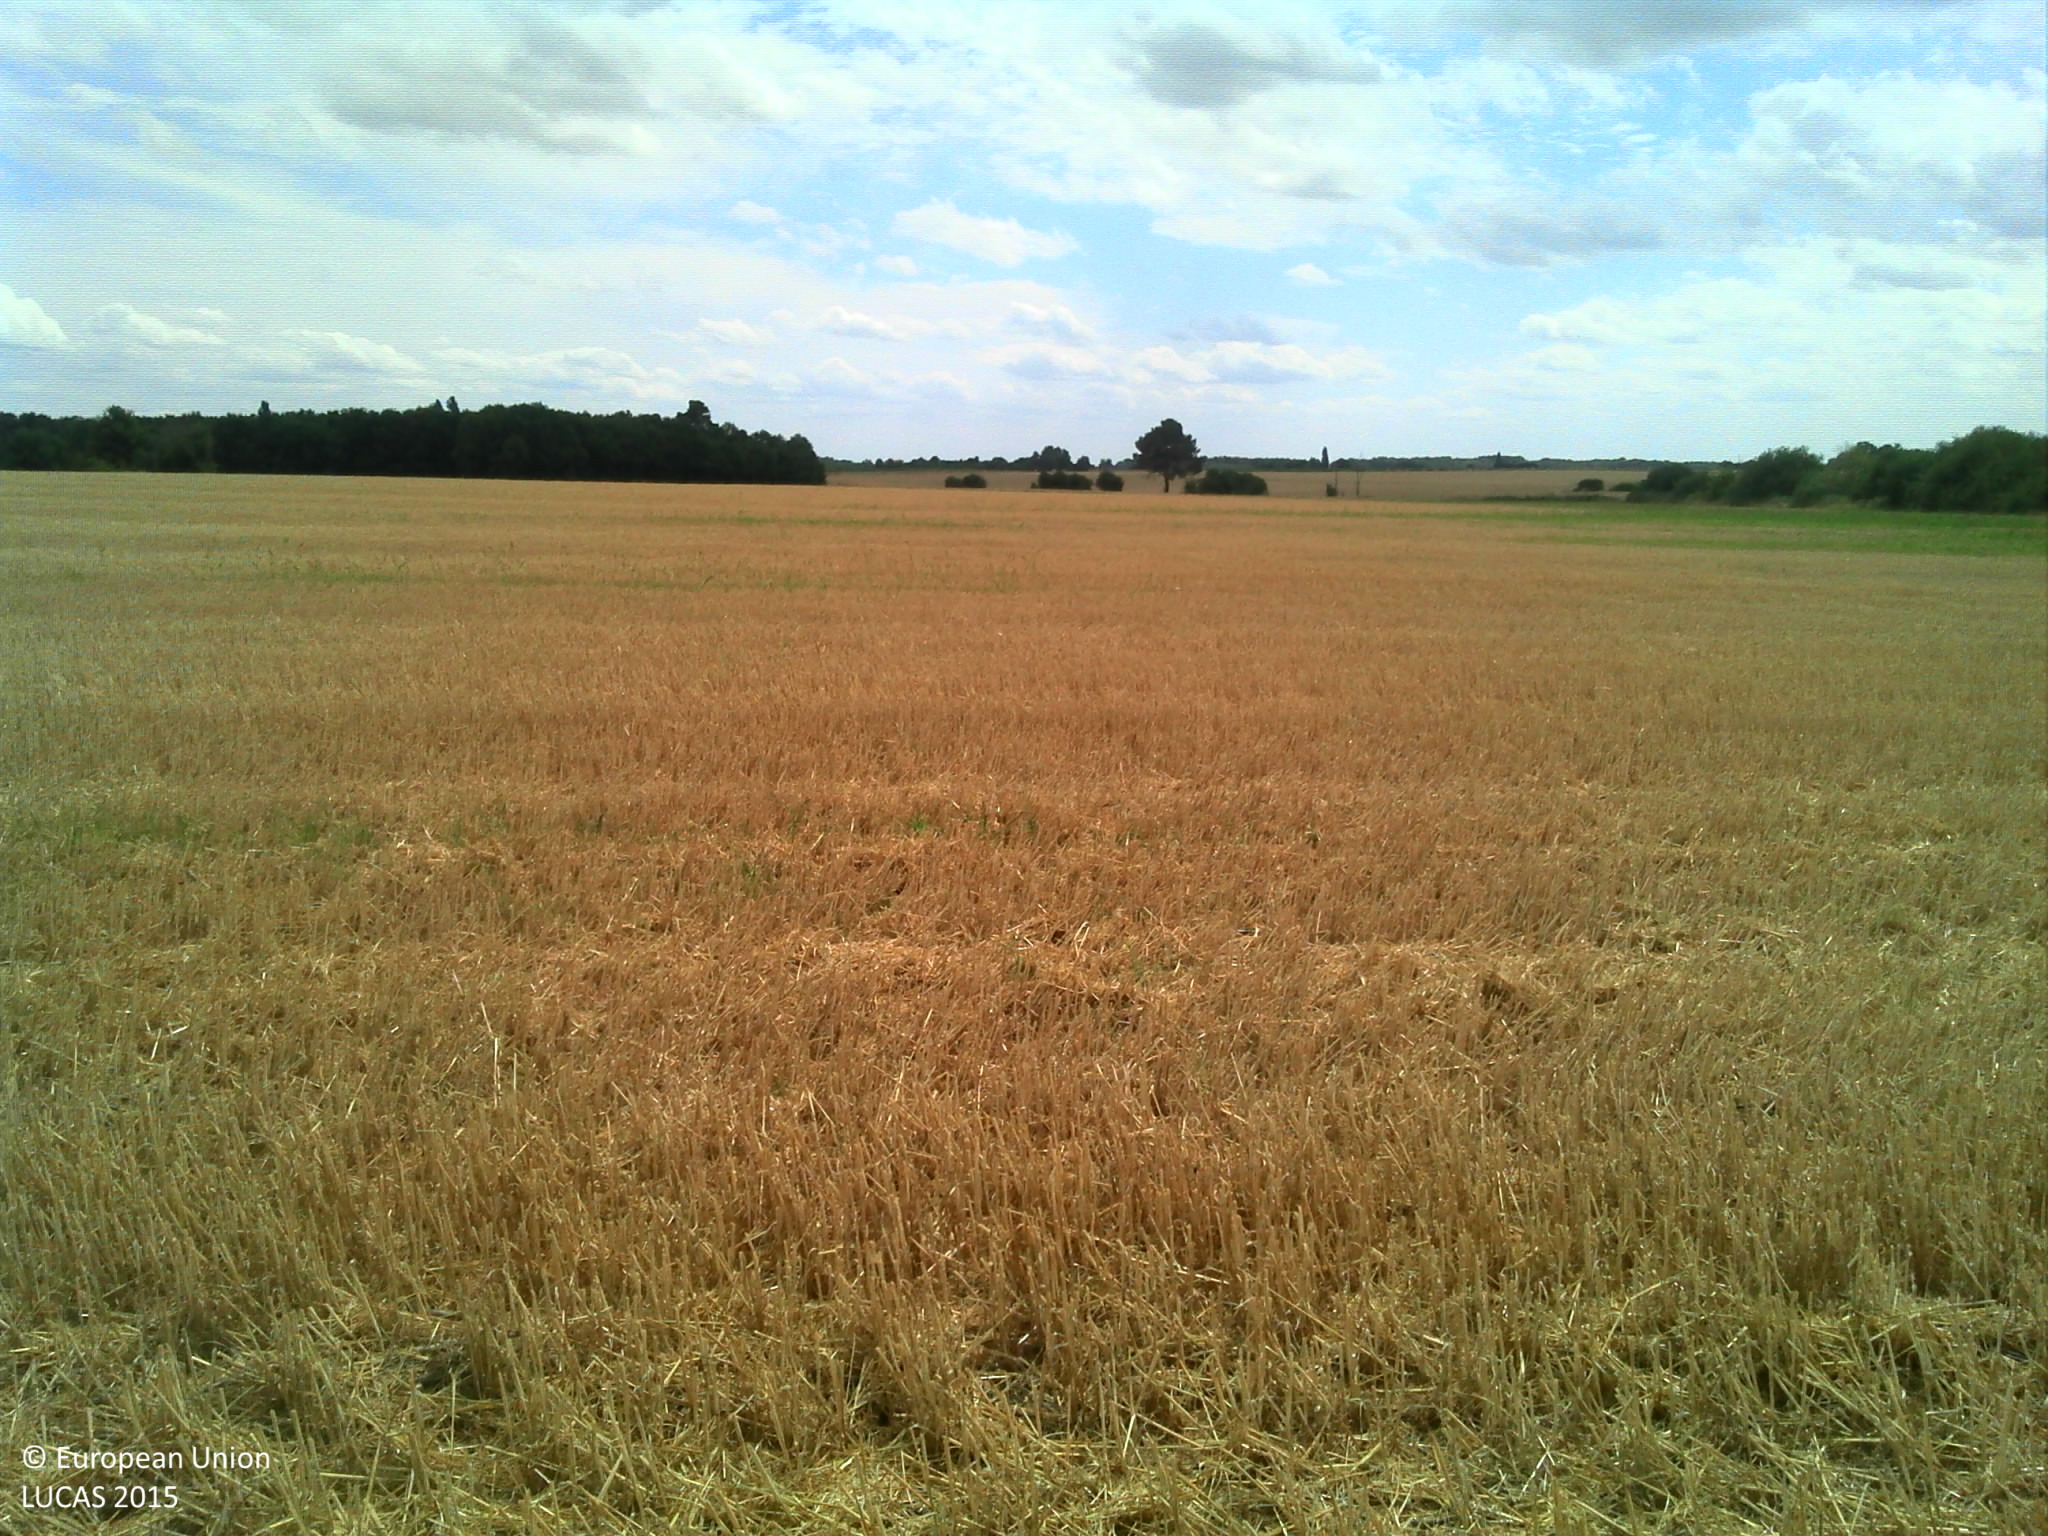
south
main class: Cropland
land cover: Common wheat
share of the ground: > 75 %
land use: Agriculture (excluding fallow land and kitchen gardens)
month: July
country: FR
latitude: 47.0910
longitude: 0.7475
